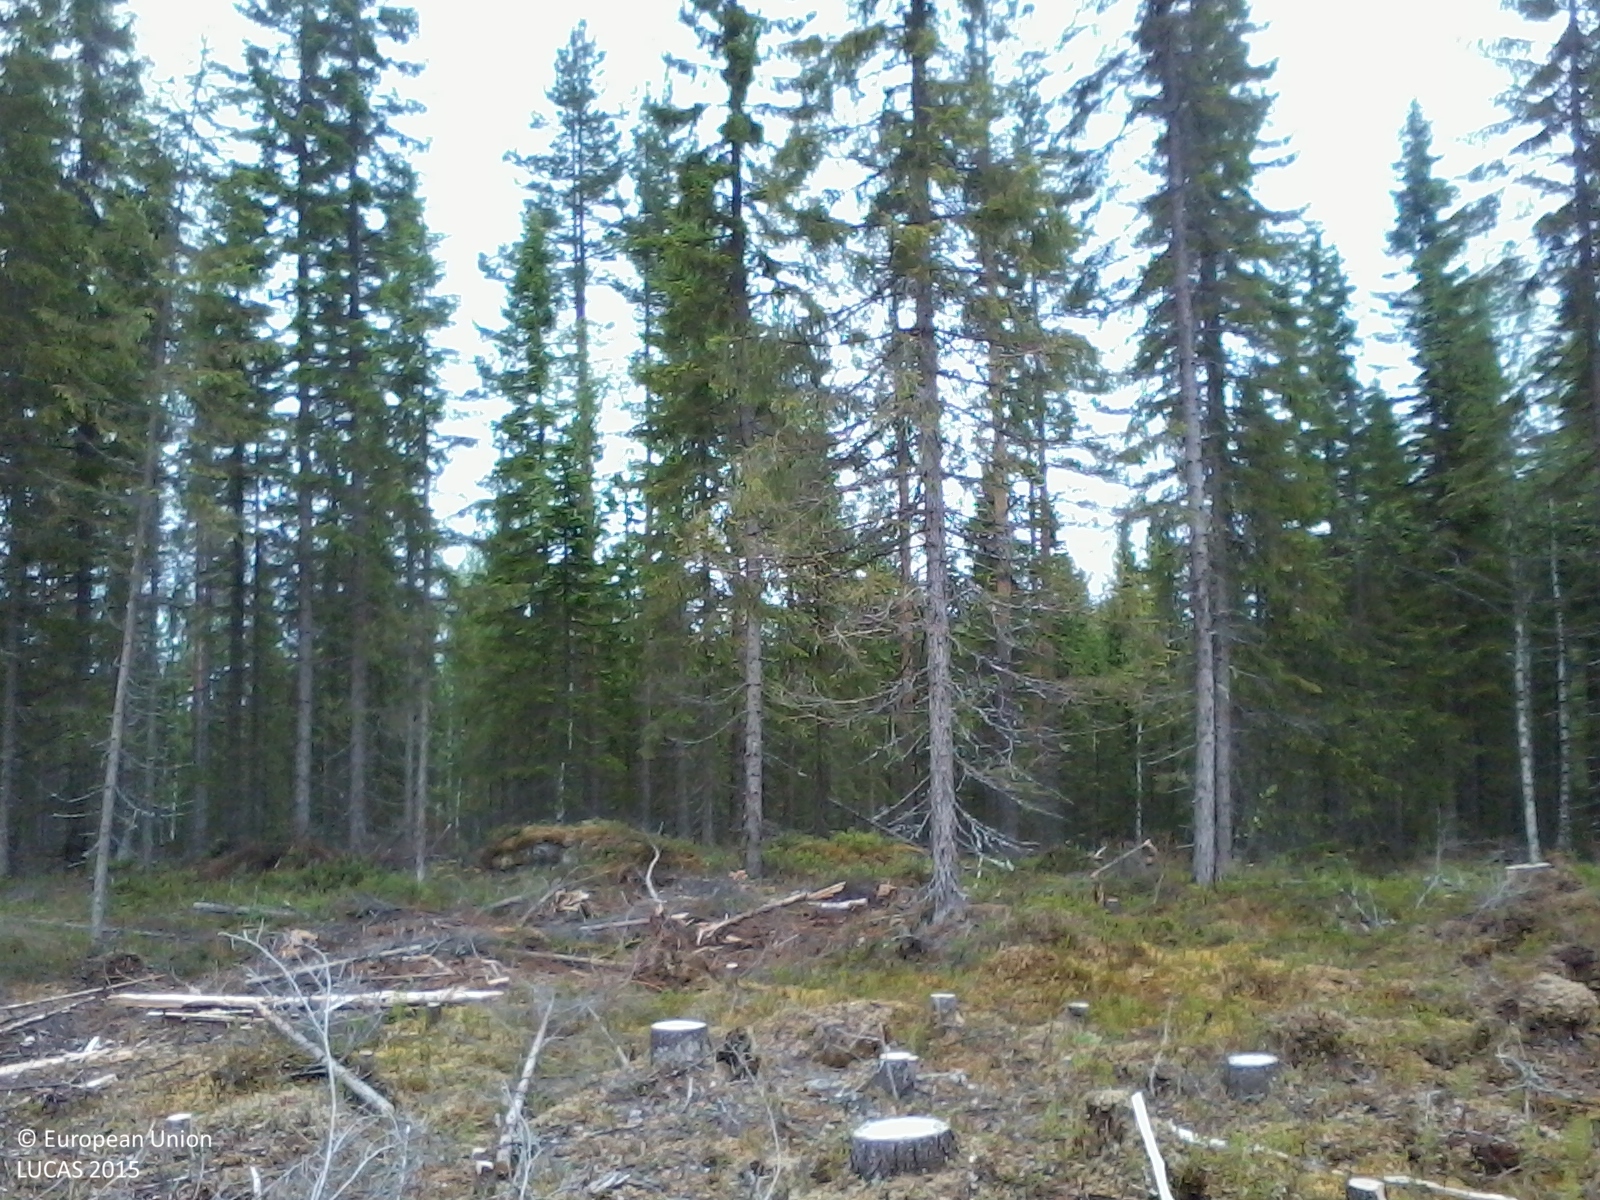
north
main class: Shrubland
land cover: Shrubland without tree cover
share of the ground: 10 - 25 %
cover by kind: shrubs 15 %, herbaceous plants 15 %, lichens and mosses 15 %, consolidated bare surface 10 %
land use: Forestry
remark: Clear cut
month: June
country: SE
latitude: 63.4351
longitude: 17.9720
